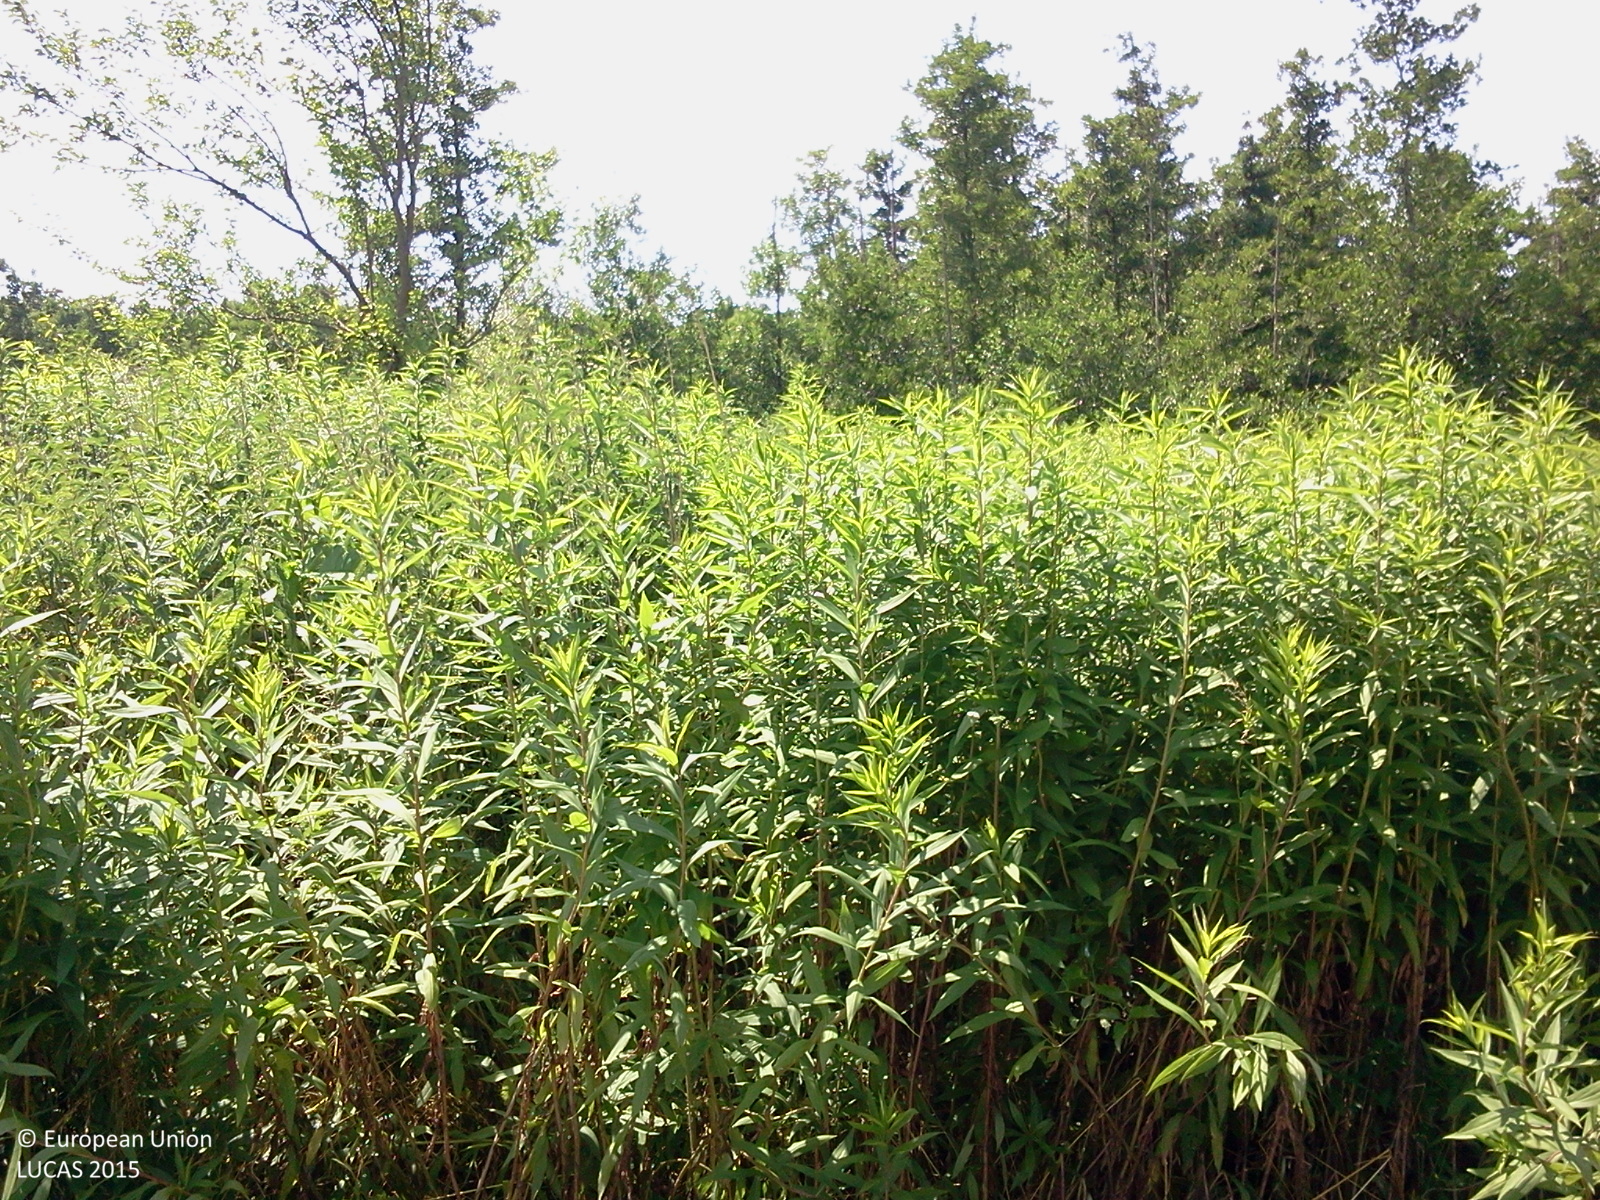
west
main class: Grassland
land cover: Grassland without tree/shrub cover
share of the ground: > 75 %
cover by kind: herbaceous plants 100 %
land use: Agriculture (excluding fallow land and kitchen gardens)
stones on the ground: < 10 %
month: June
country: HU
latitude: 46.7377
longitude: 16.9790
